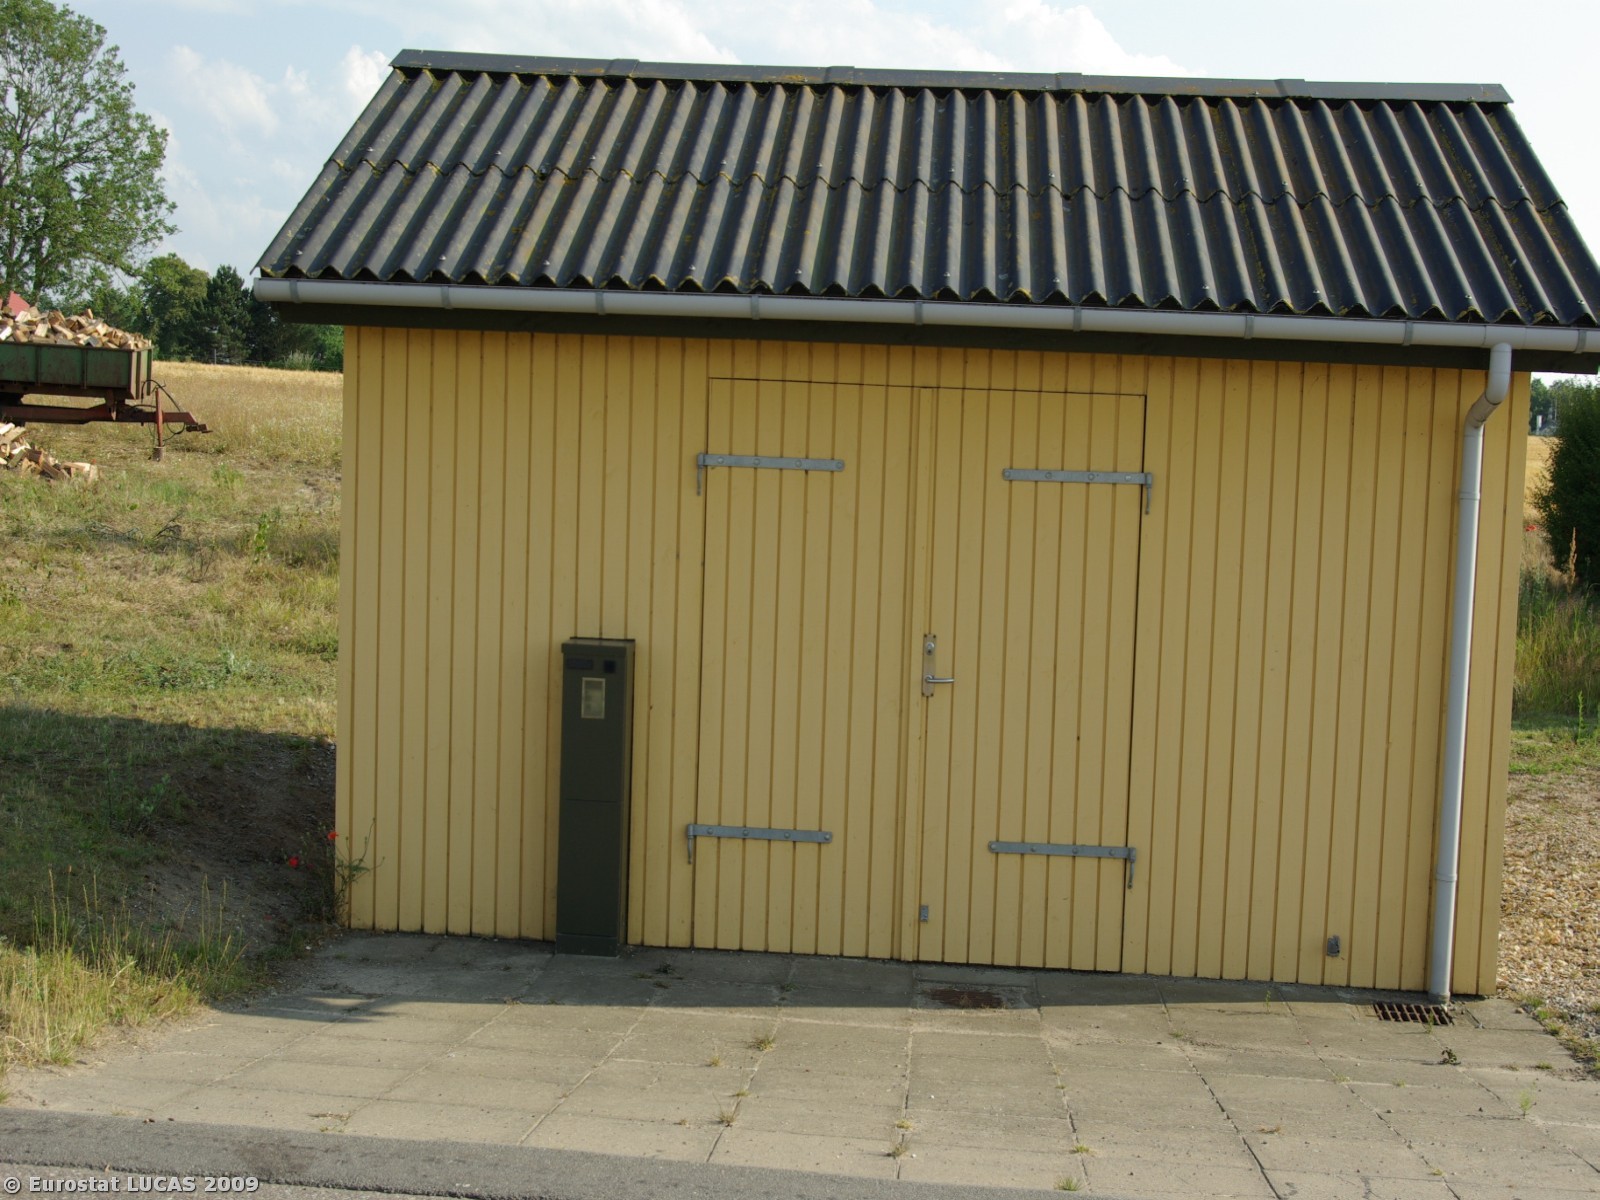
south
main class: Cropland
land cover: Common wheat
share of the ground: > 75 %
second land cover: Triticale
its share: 25 - 50 %
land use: Agriculture (excluding fallow land and kitchen gardens)
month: July
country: DK
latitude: 55.0550
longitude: 9.7028
